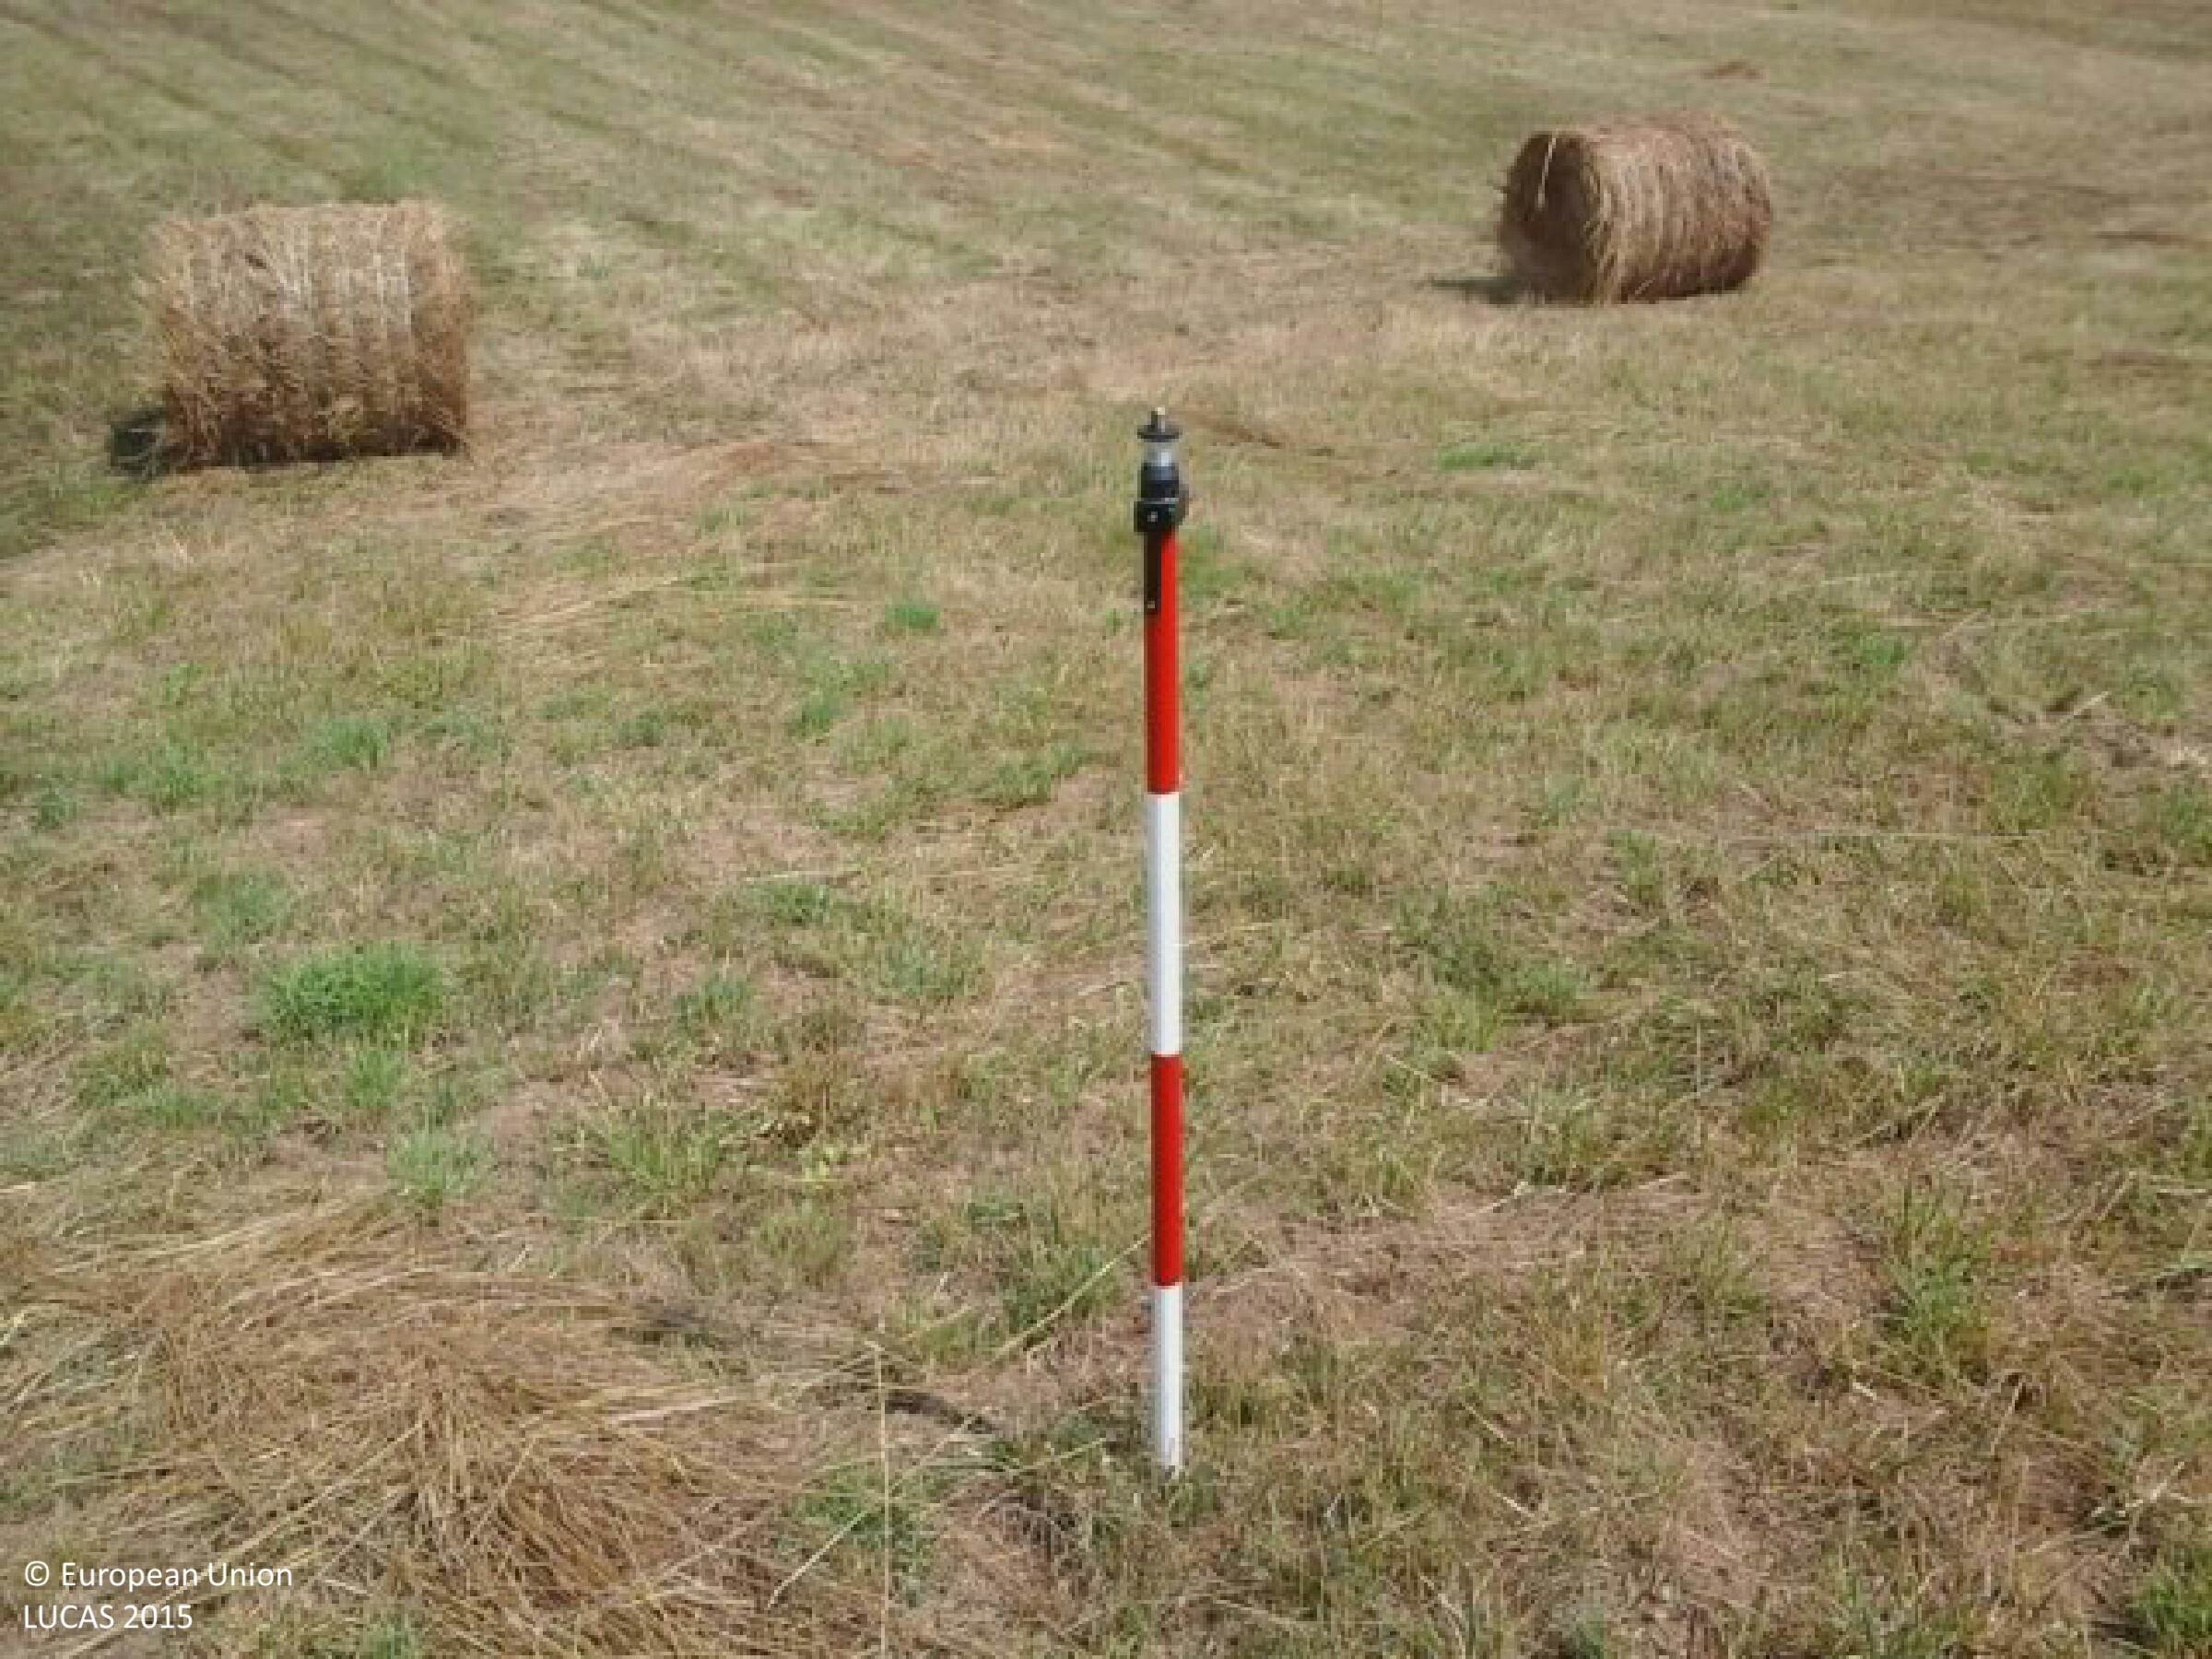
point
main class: Grassland
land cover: Grassland without tree/shrub cover
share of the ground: > 75 %
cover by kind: herbaceous plants 100 %
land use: Agriculture (excluding fallow land and kitchen gardens)
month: July
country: HU
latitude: 47.9820
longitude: 20.0365
